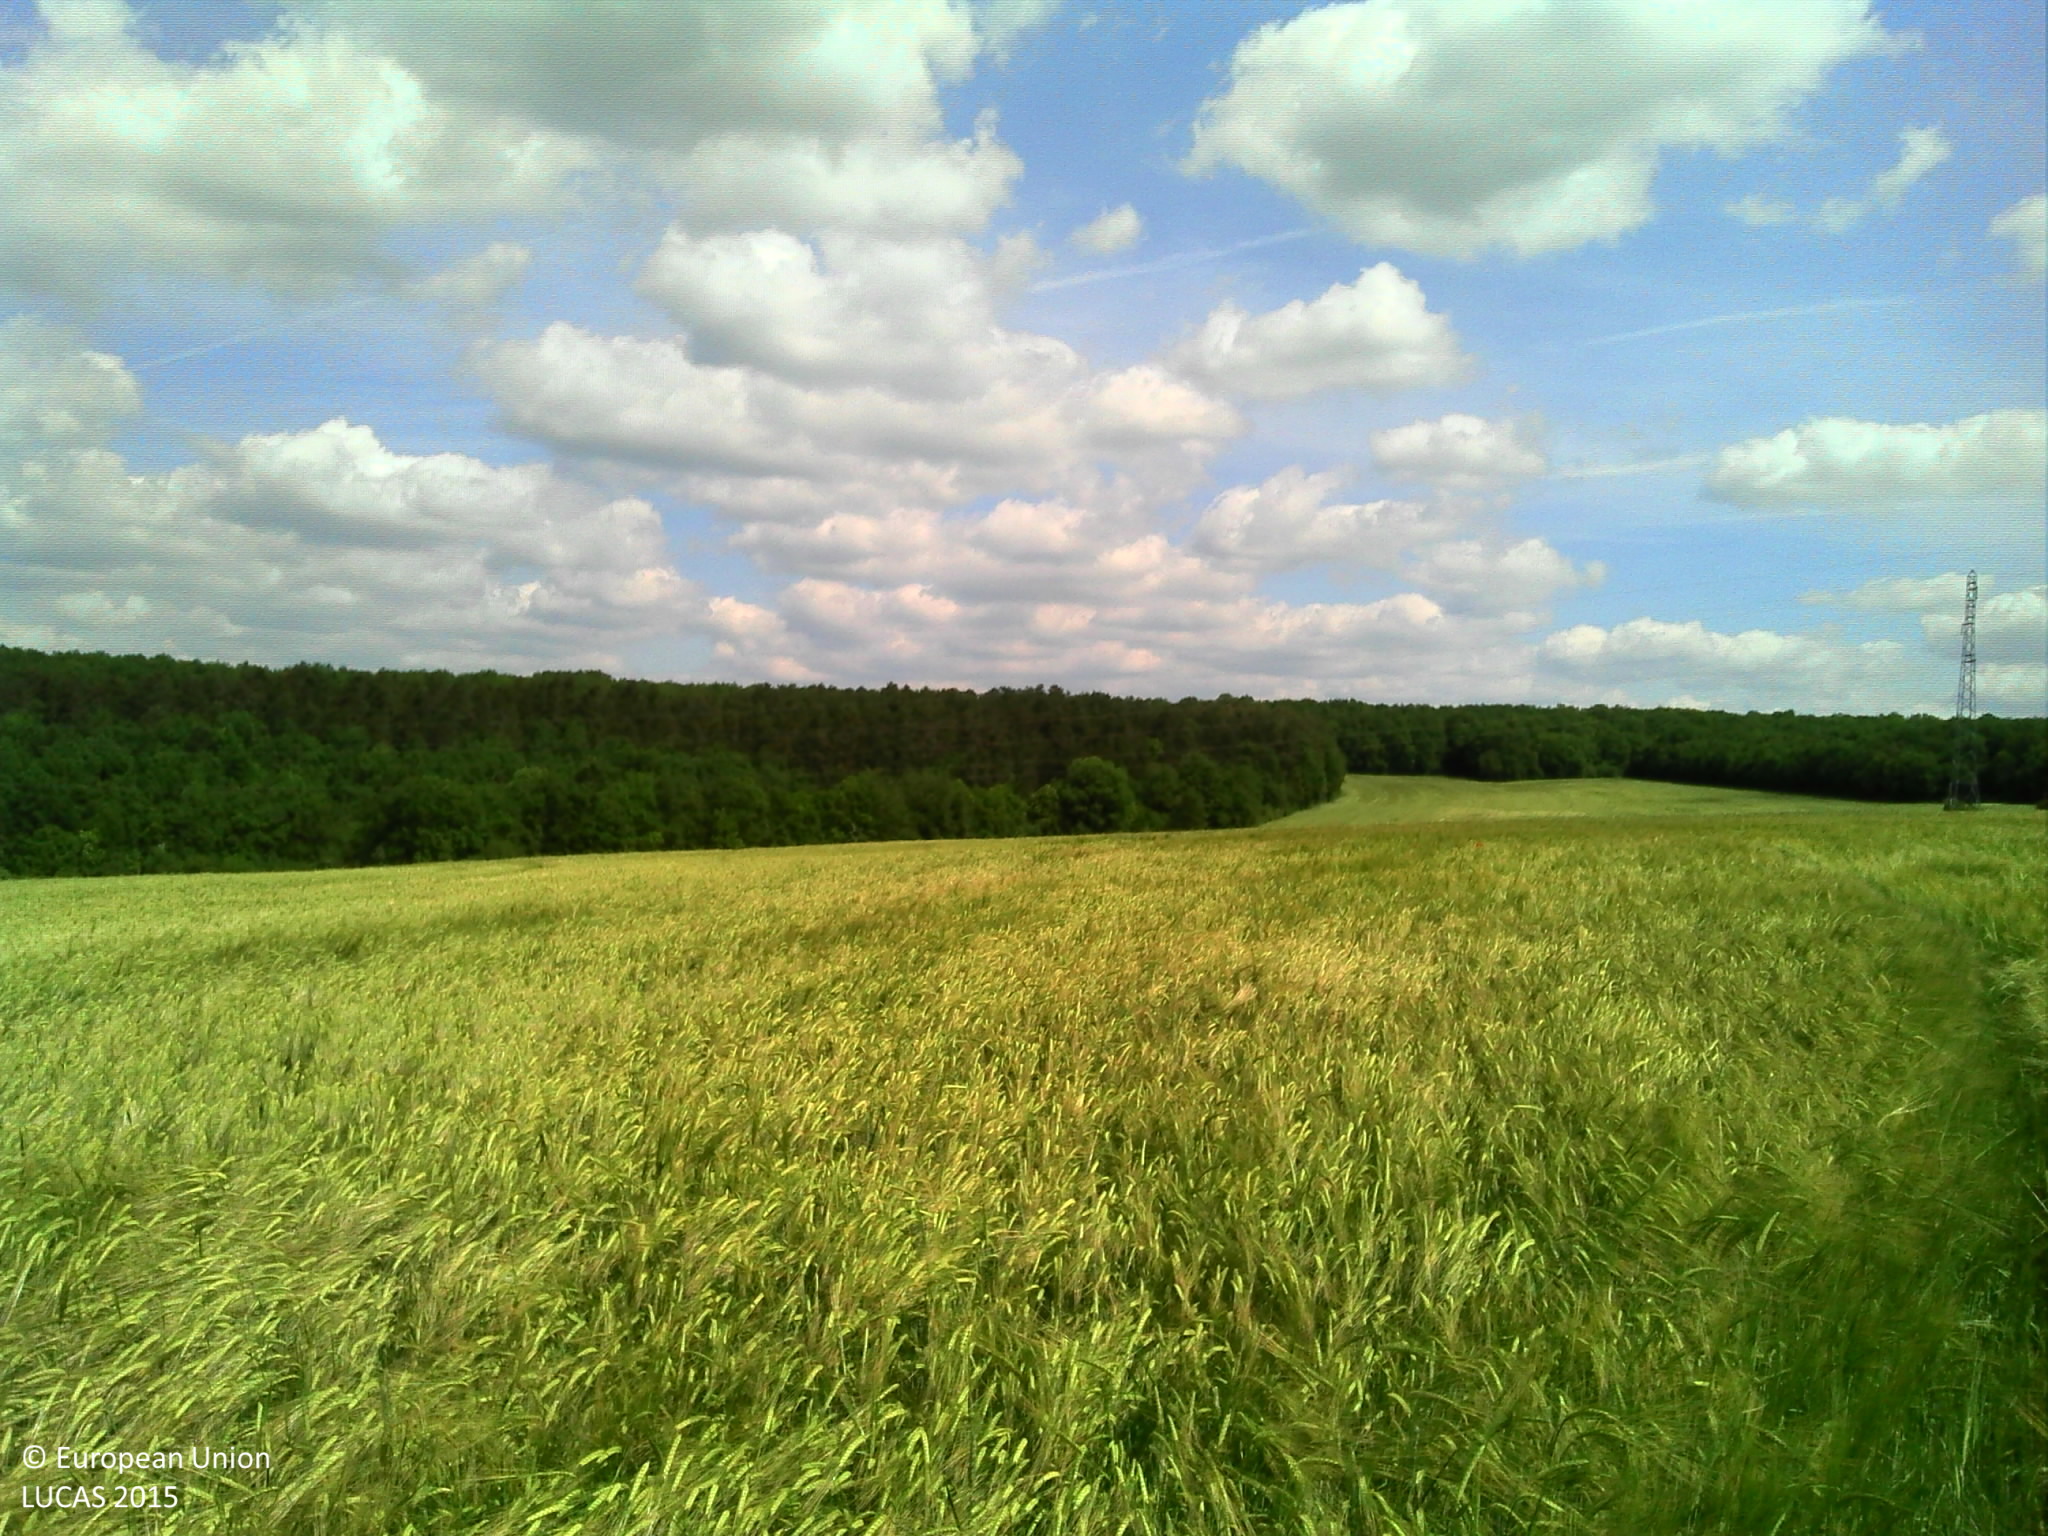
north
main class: Cropland
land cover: Barley
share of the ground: > 75 %
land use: Agriculture (excluding fallow land and kitchen gardens)
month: May
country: FR
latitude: 47.3304
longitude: 4.9056
